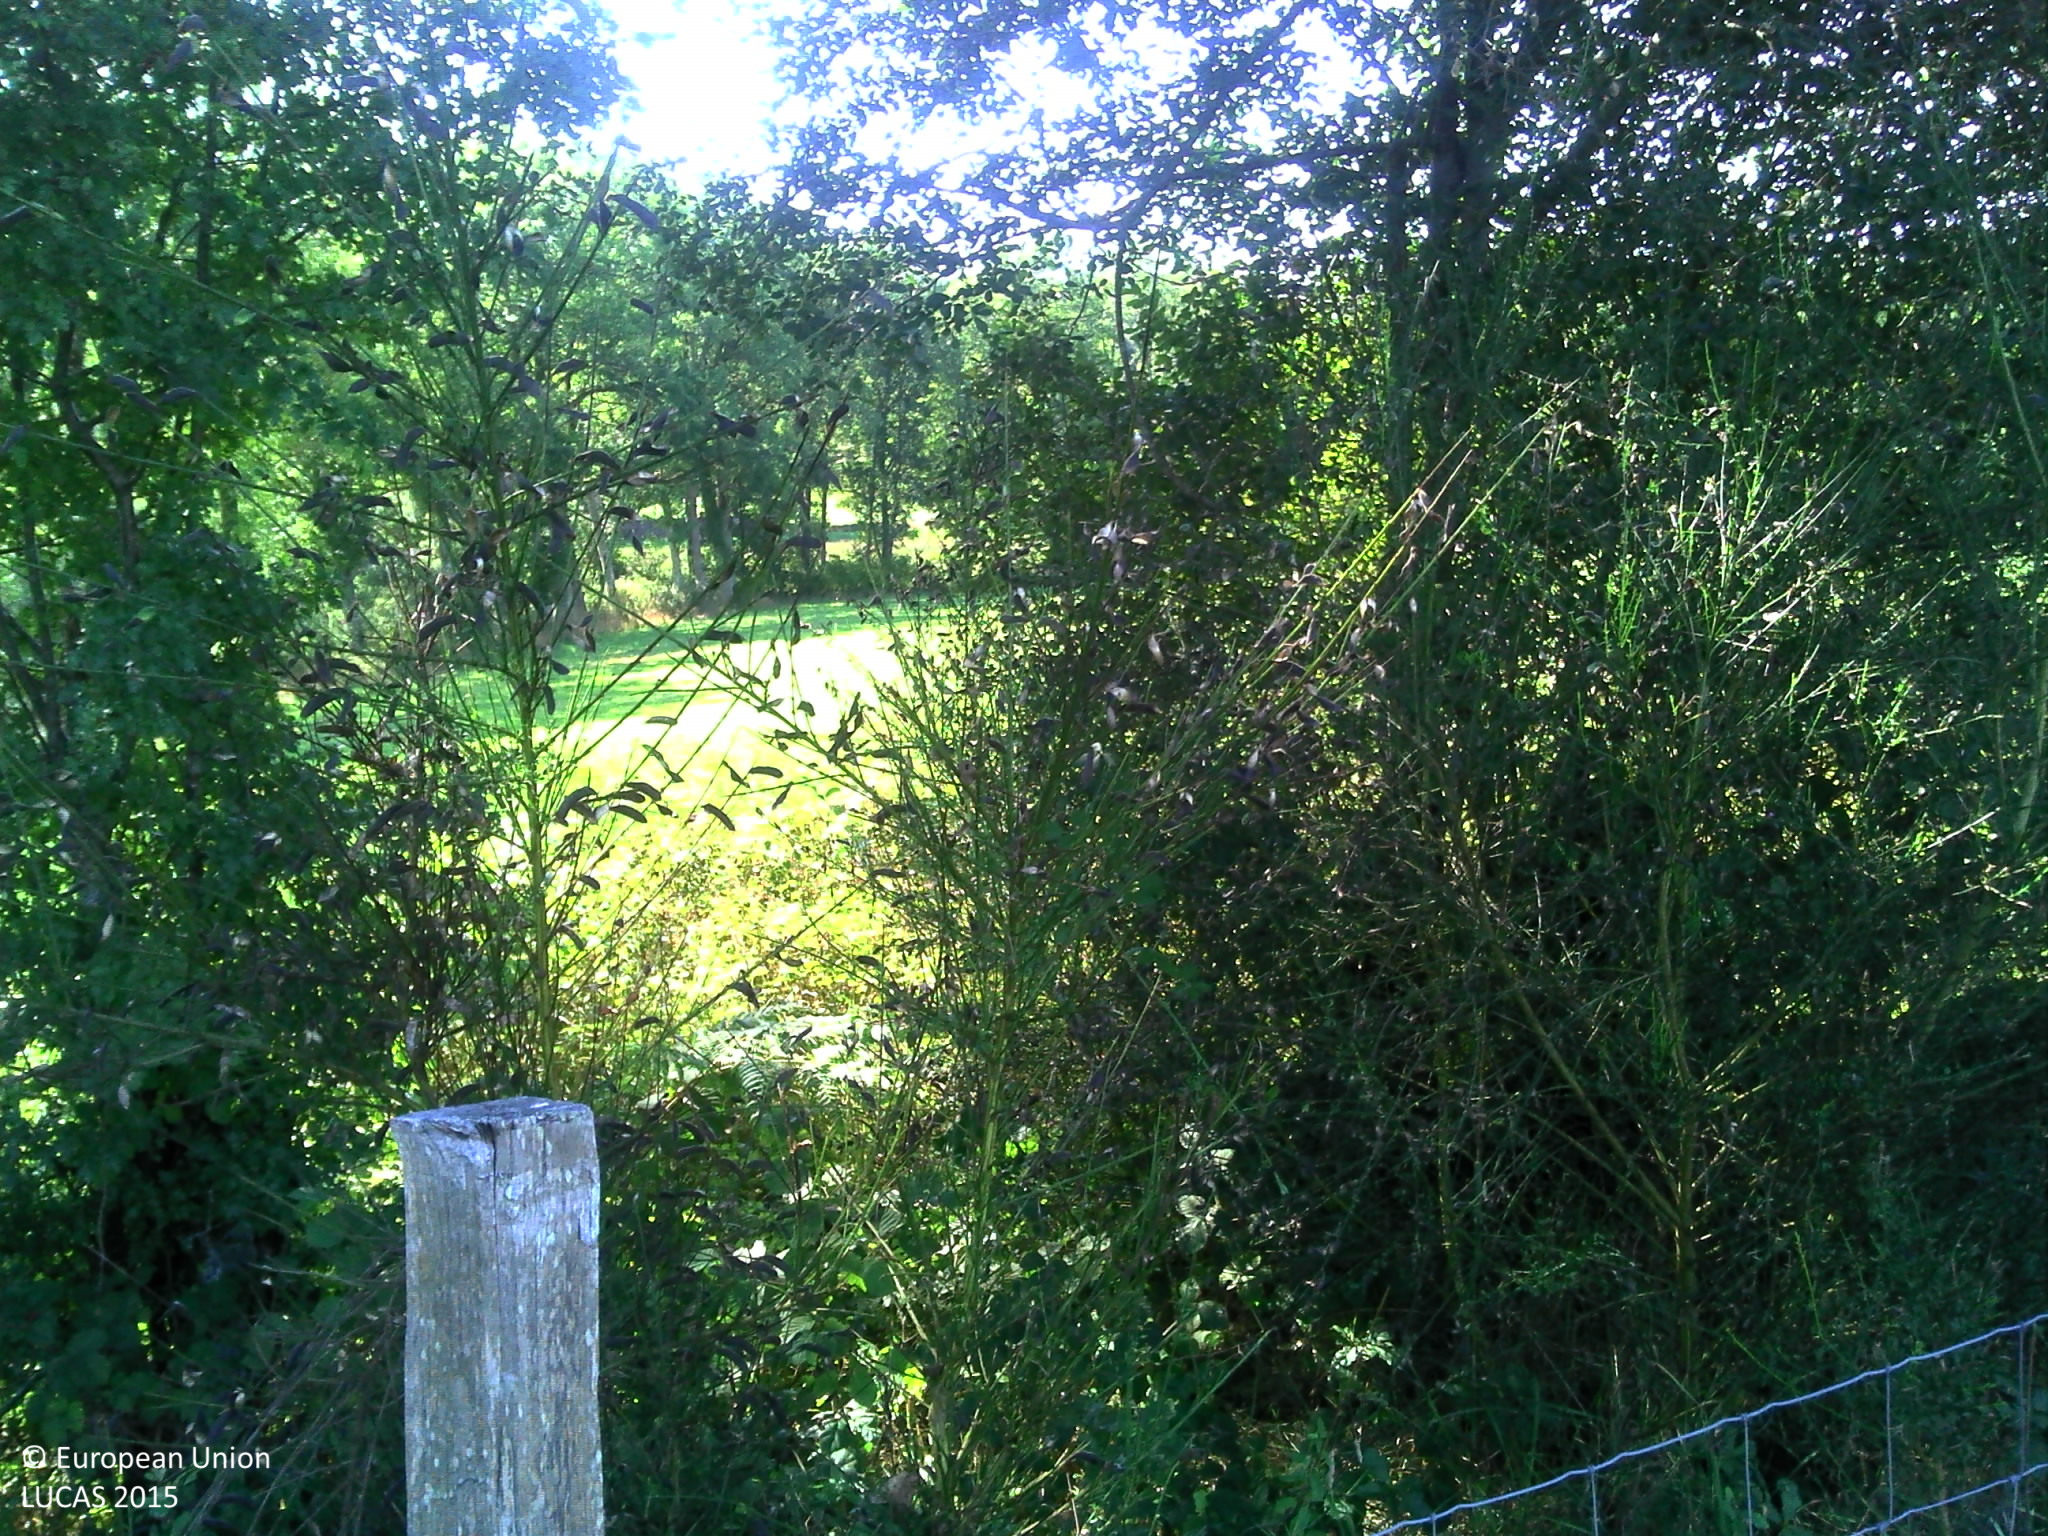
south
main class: Grassland
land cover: Grassland without tree/shrub cover
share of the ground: > 75 %
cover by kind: herbaceous plants 100 %
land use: Agriculture (excluding fallow land and kitchen gardens)
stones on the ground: < 10 %
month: August
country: FR
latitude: 45.9247
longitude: 2.2460
